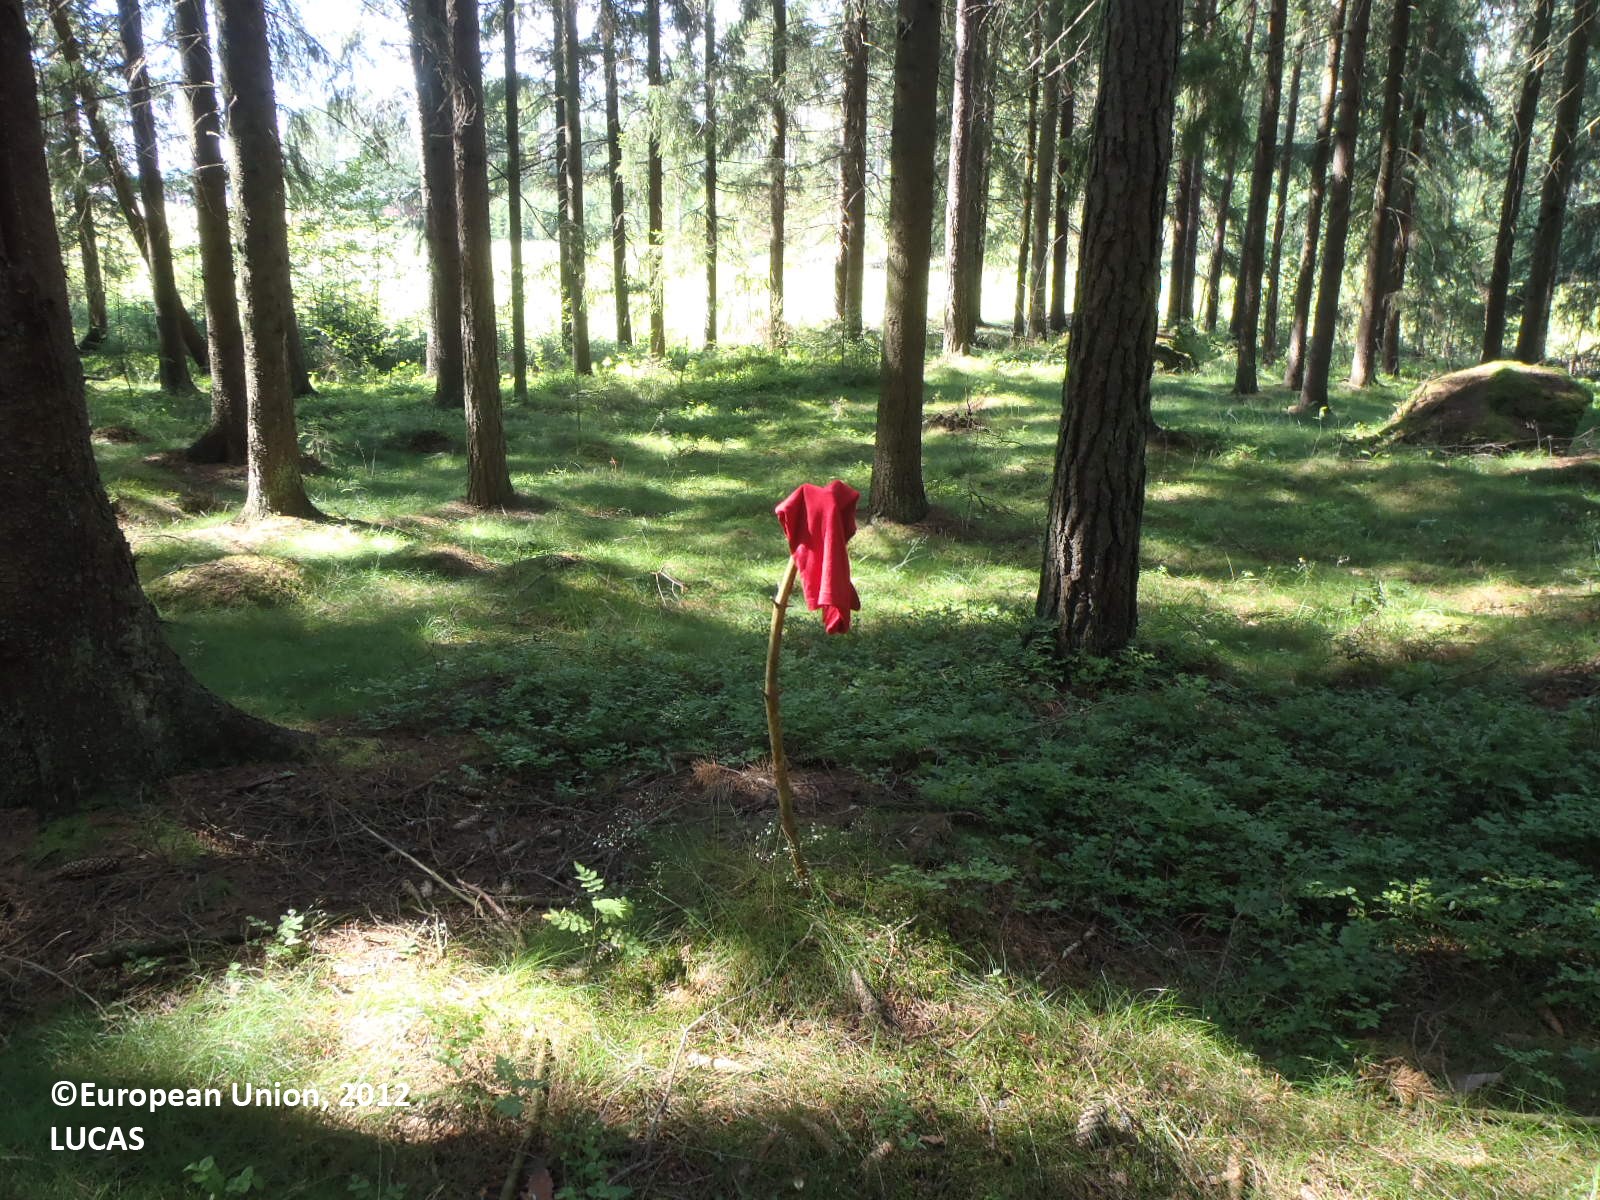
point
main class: Woodland
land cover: Other coniferous woodland
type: boreal forest
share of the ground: > 75 %
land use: Forestry
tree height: > 5 m
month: July
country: FI
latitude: 60.7103
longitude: 21.7309
